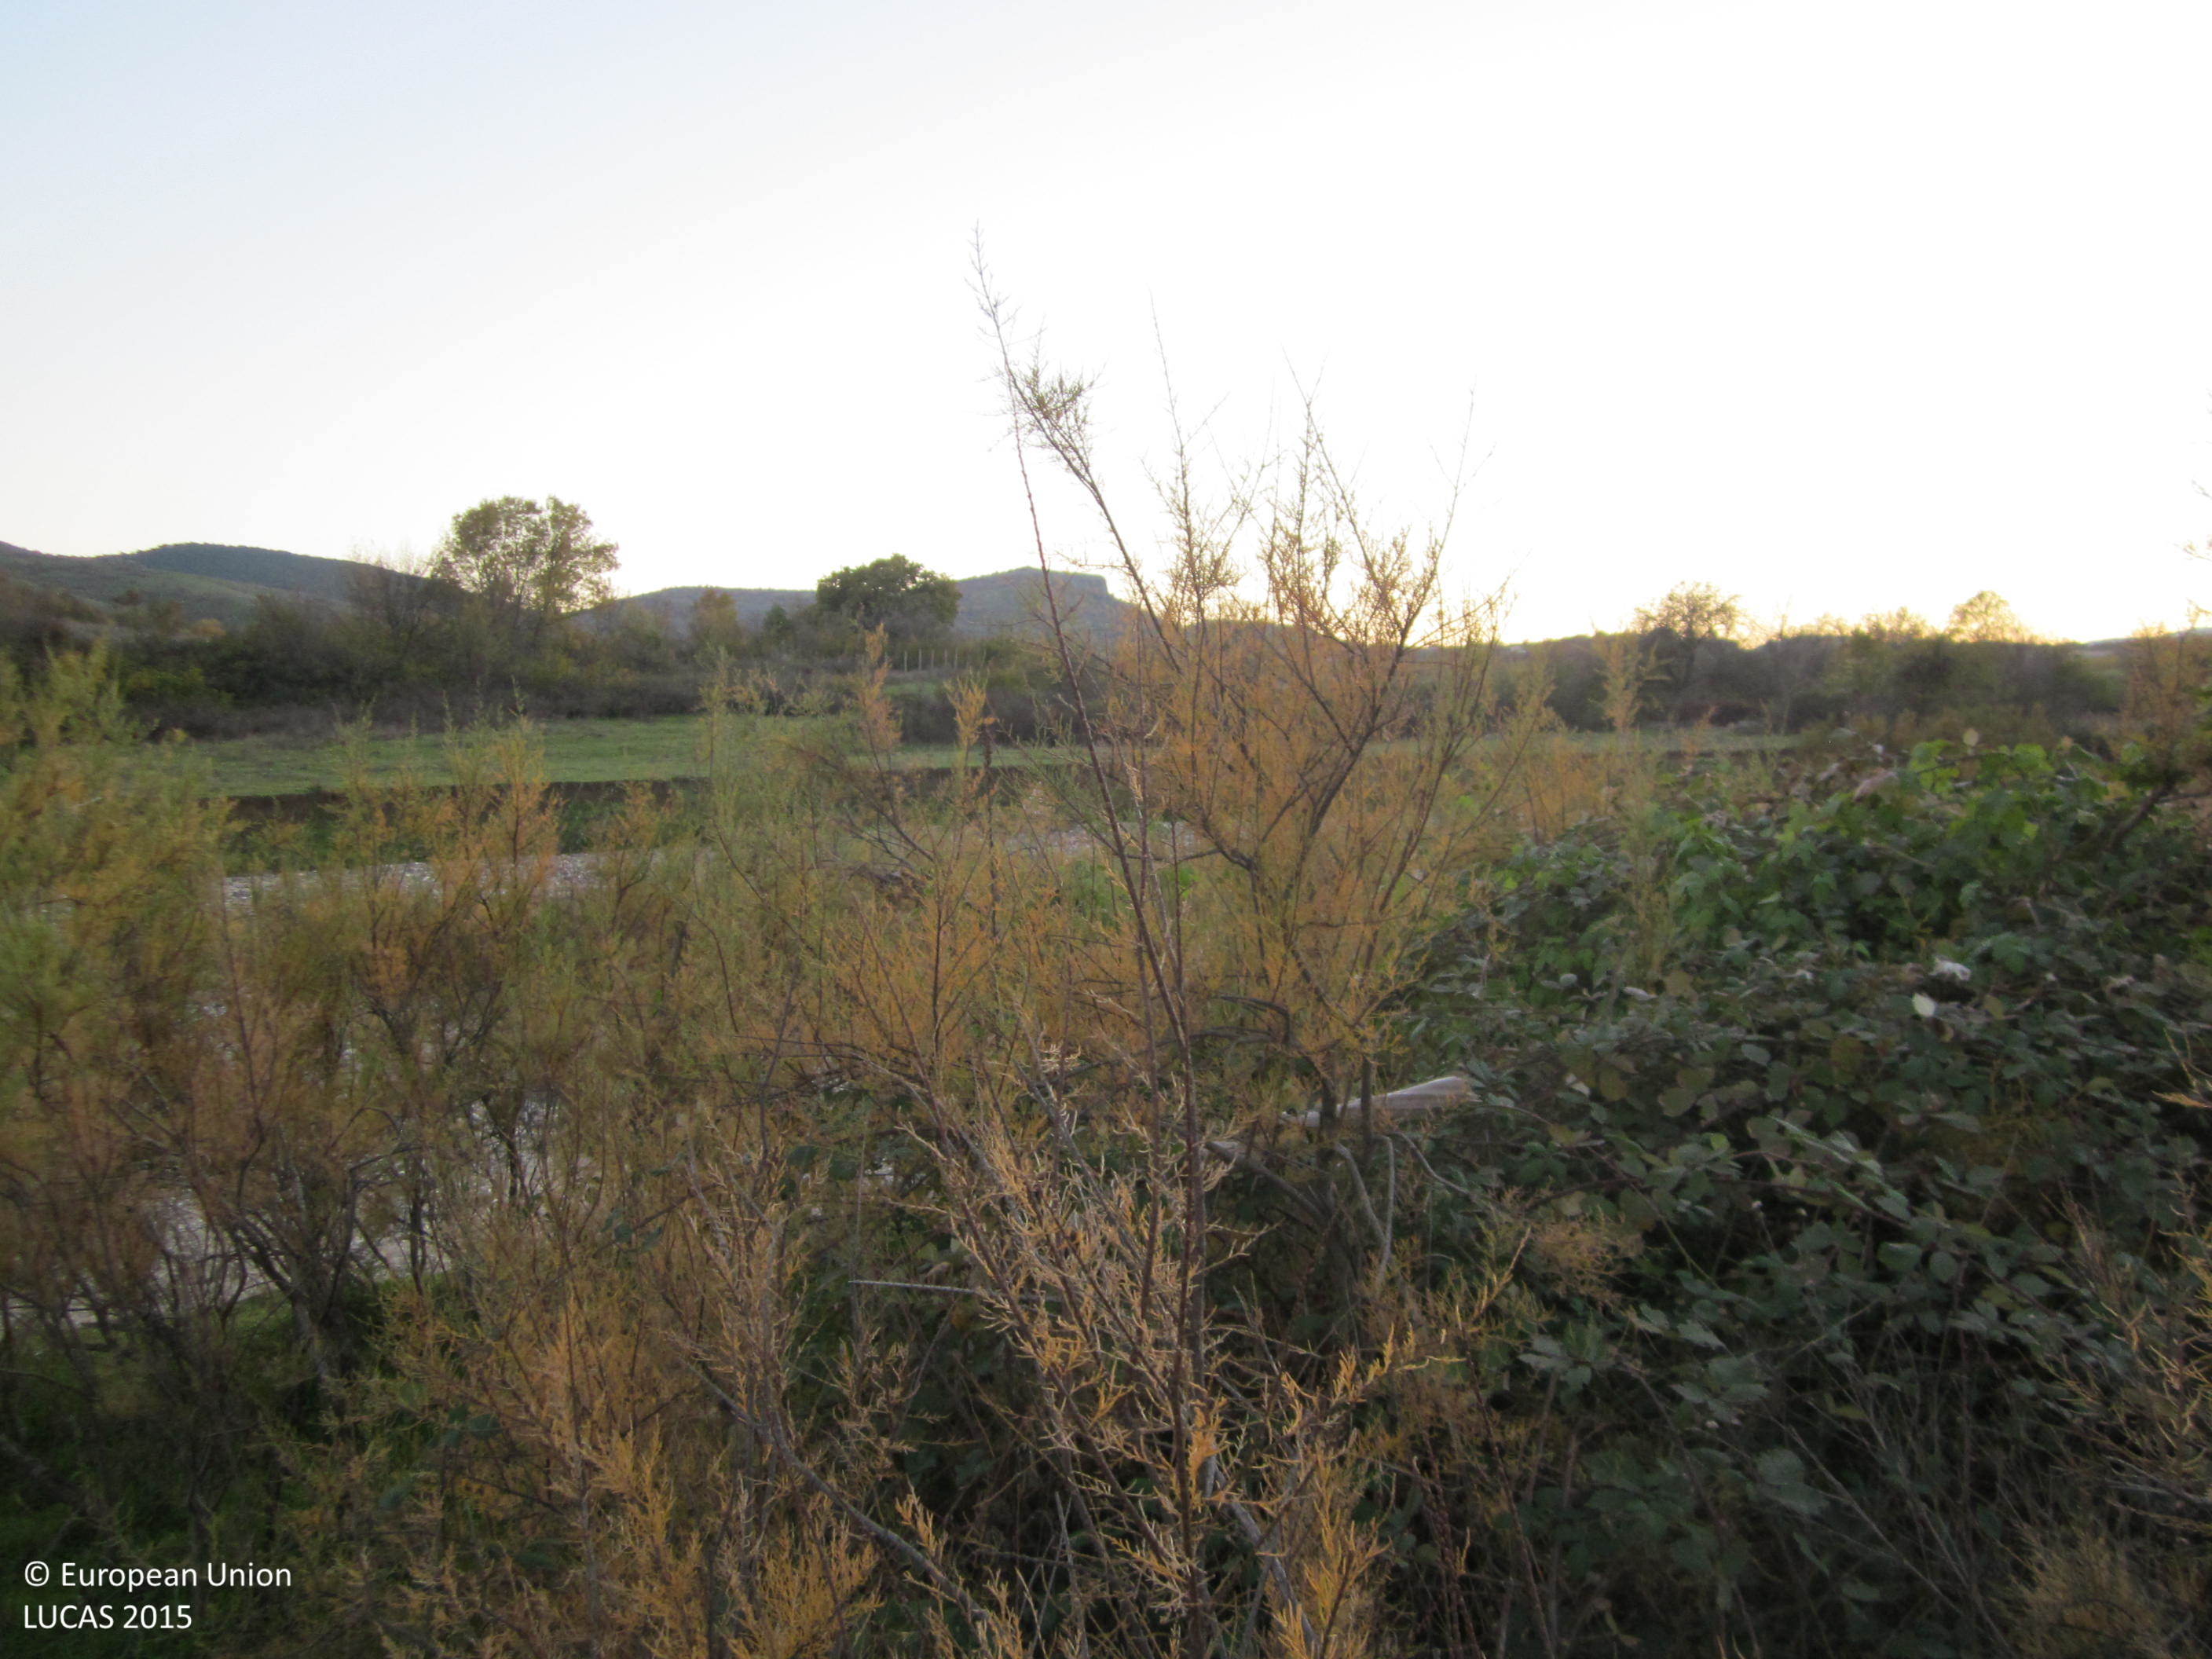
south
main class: Shrubland
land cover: Shrubland with sparse tree cover
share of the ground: 50 - 75 %
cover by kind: shrubs 50 %, herbaceous plants 45 %, broadleaved forest trees 5 %
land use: Semi-natural and natural areas not in use
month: November
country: BG
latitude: 41.5241
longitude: 25.6275
